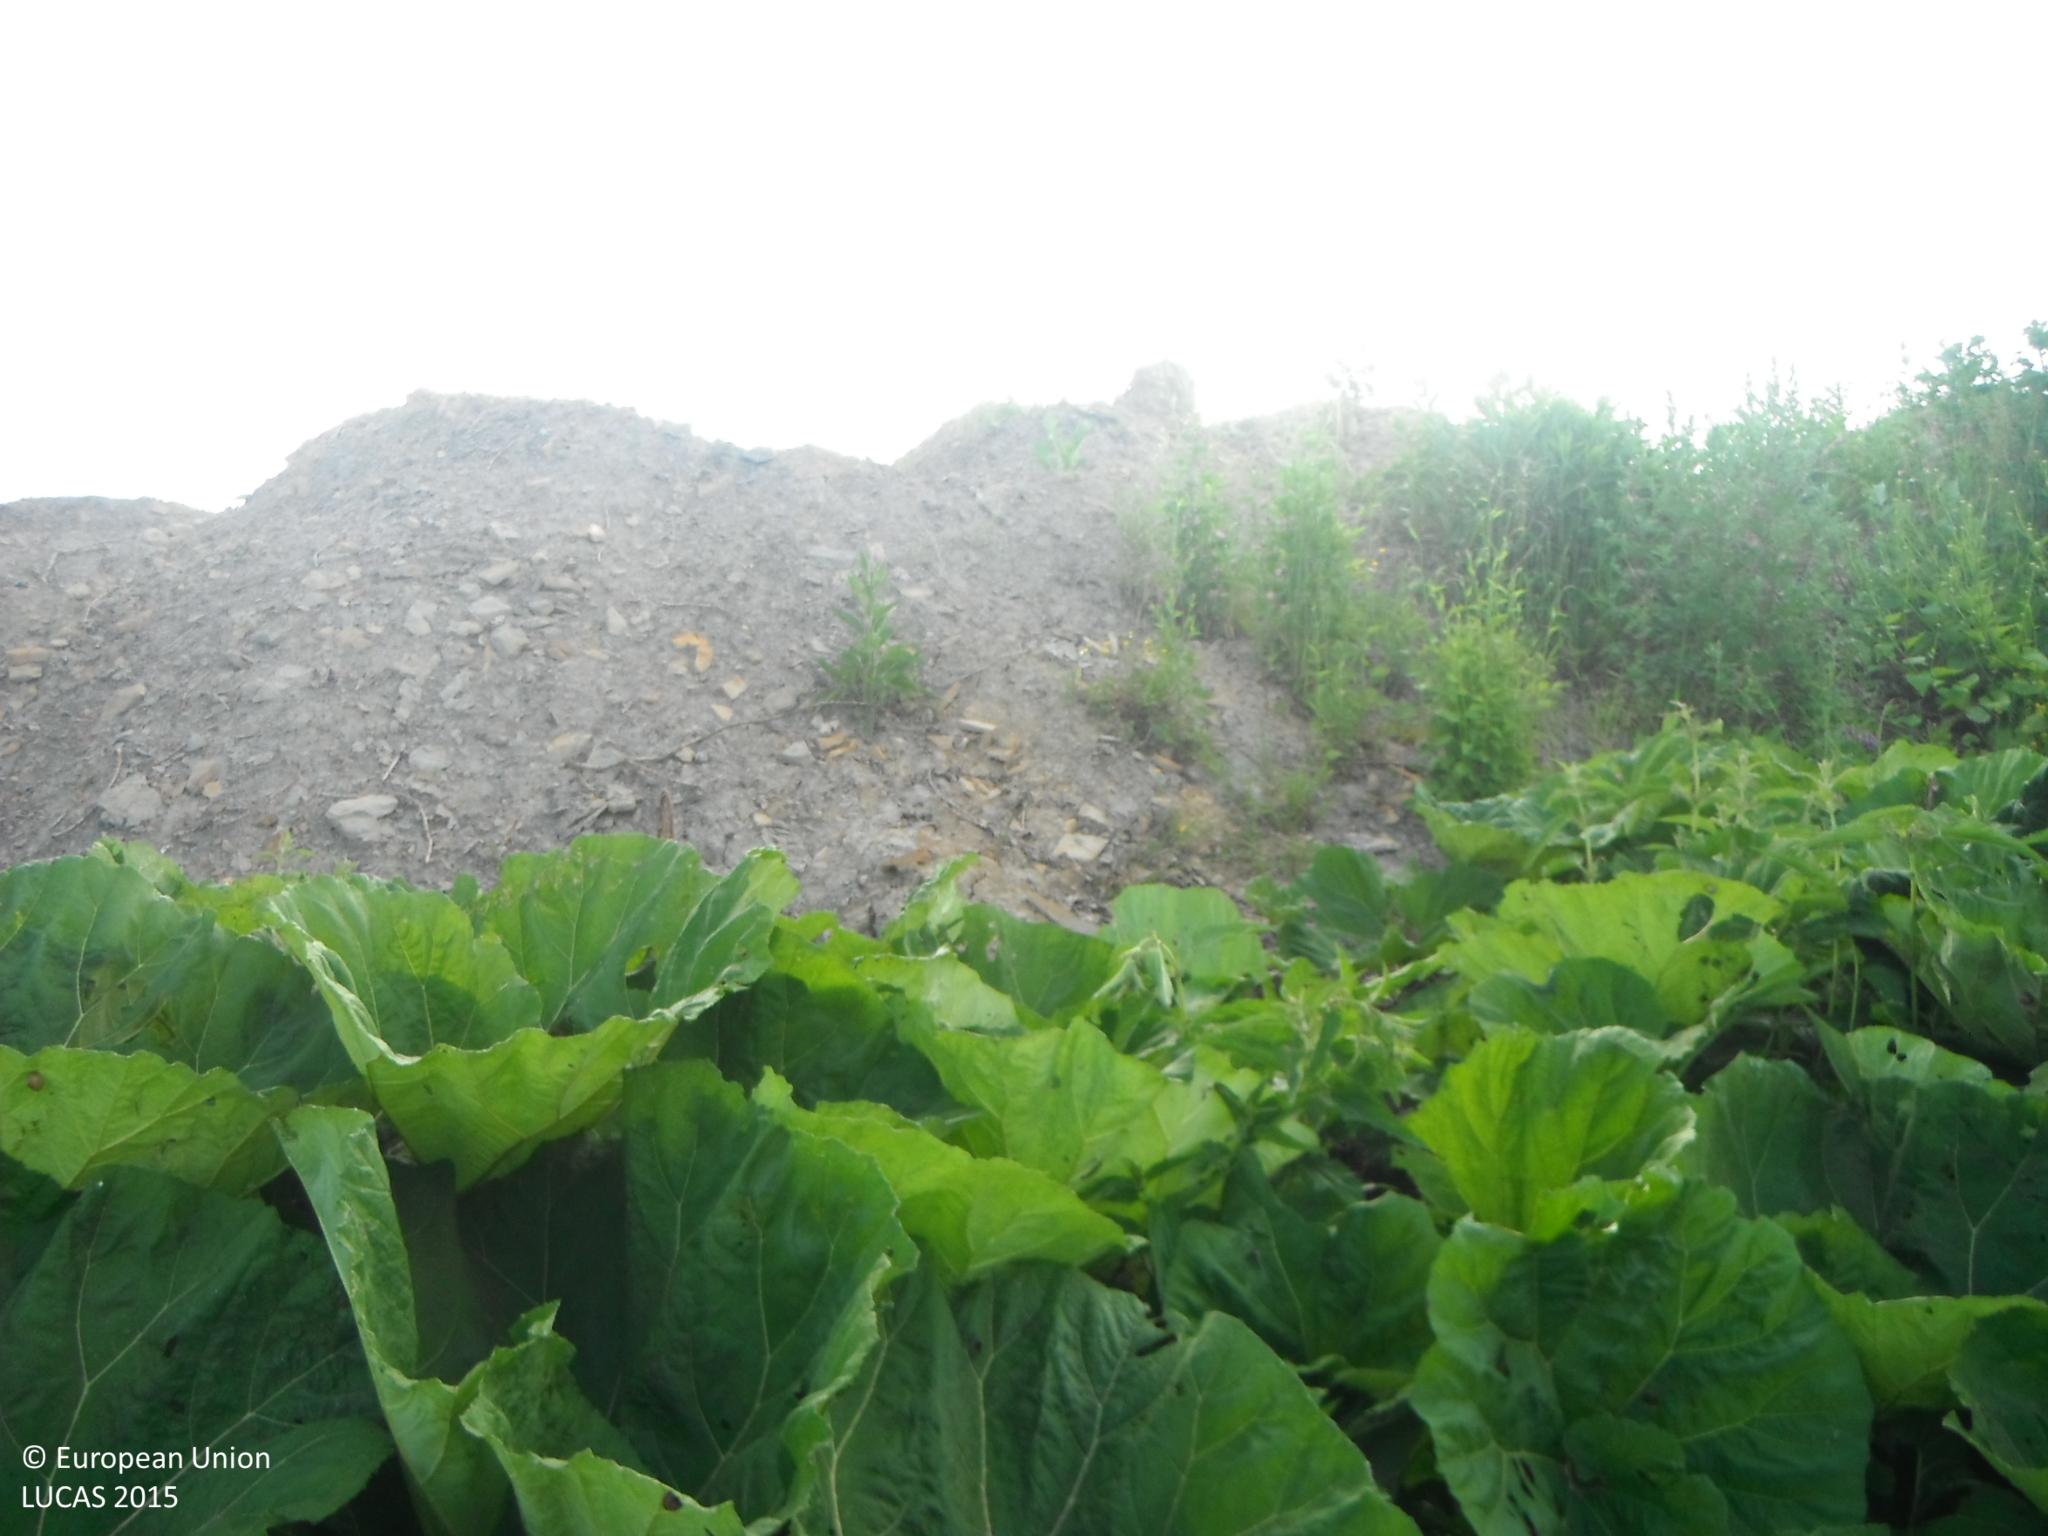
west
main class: Grassland
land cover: Spontaneously vegetated surfaces
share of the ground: > 75 %
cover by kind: herbaceous plants 100 %
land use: Fallow land
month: June
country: SK
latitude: 49.2354
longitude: 20.4045
